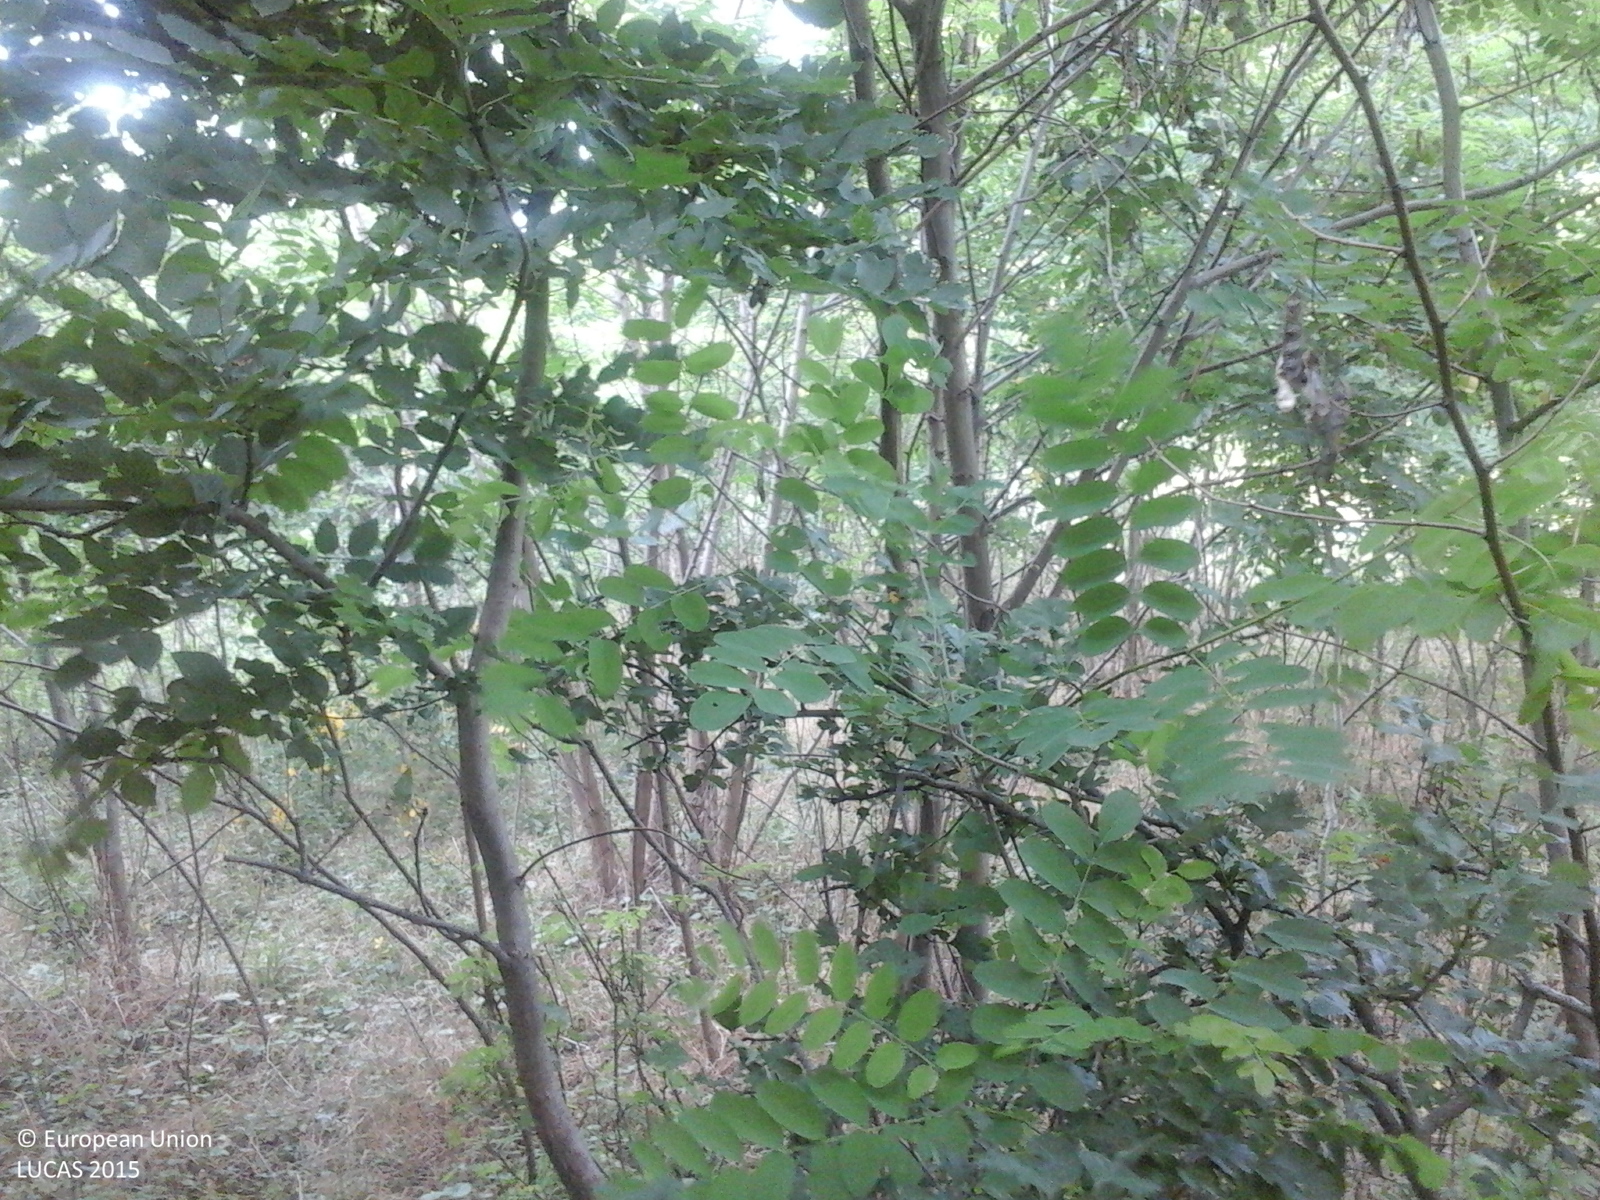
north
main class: Woodland
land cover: Broadleaved woodland
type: exotic forest
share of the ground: > 75 %
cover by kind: broadleaved forest trees 85 %, herbaceous plants 10 %, shrubs 5 %
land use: Forestry
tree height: > 5 m
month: June
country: RO
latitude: 46.7227
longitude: 27.9060
